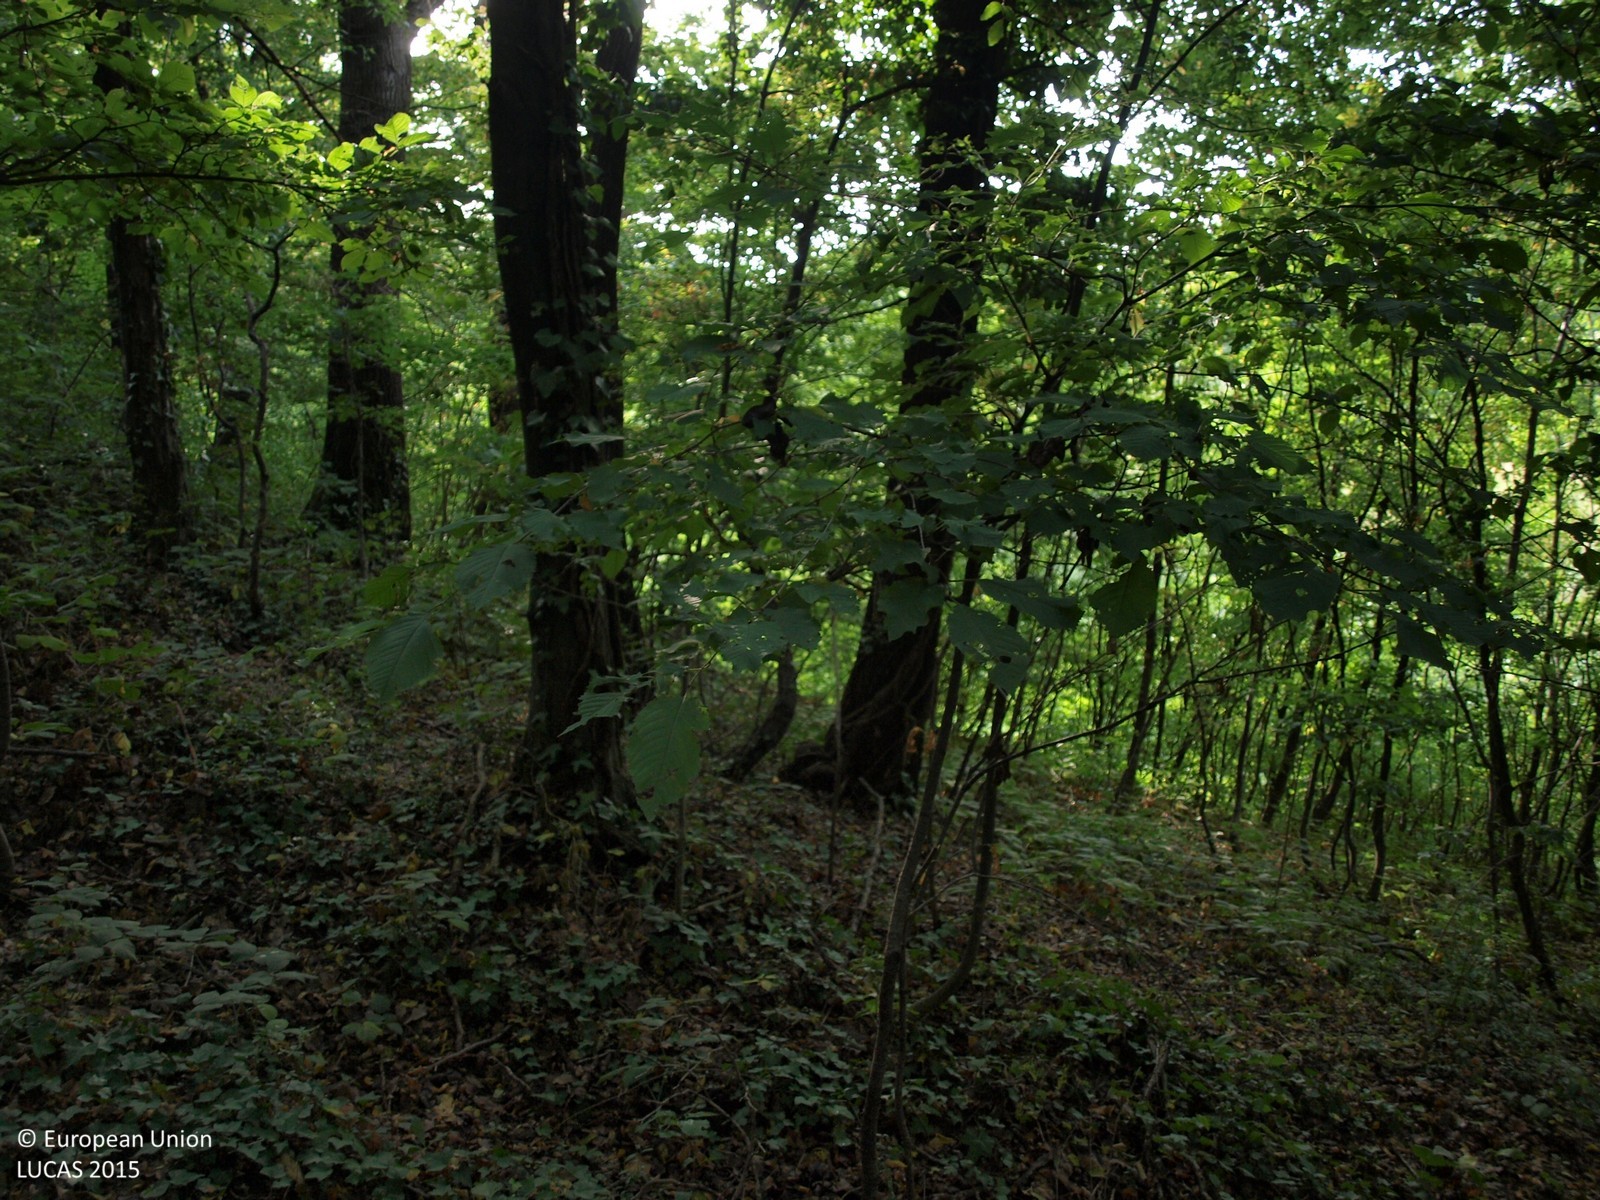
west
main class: Woodland
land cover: Broadleaved woodland
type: mesophytic deciduous forest
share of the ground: > 75 %
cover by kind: broadleaved forest trees 100 %
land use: Forestry
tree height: > 5 m
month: July
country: HR
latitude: 46.1082
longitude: 16.3520
